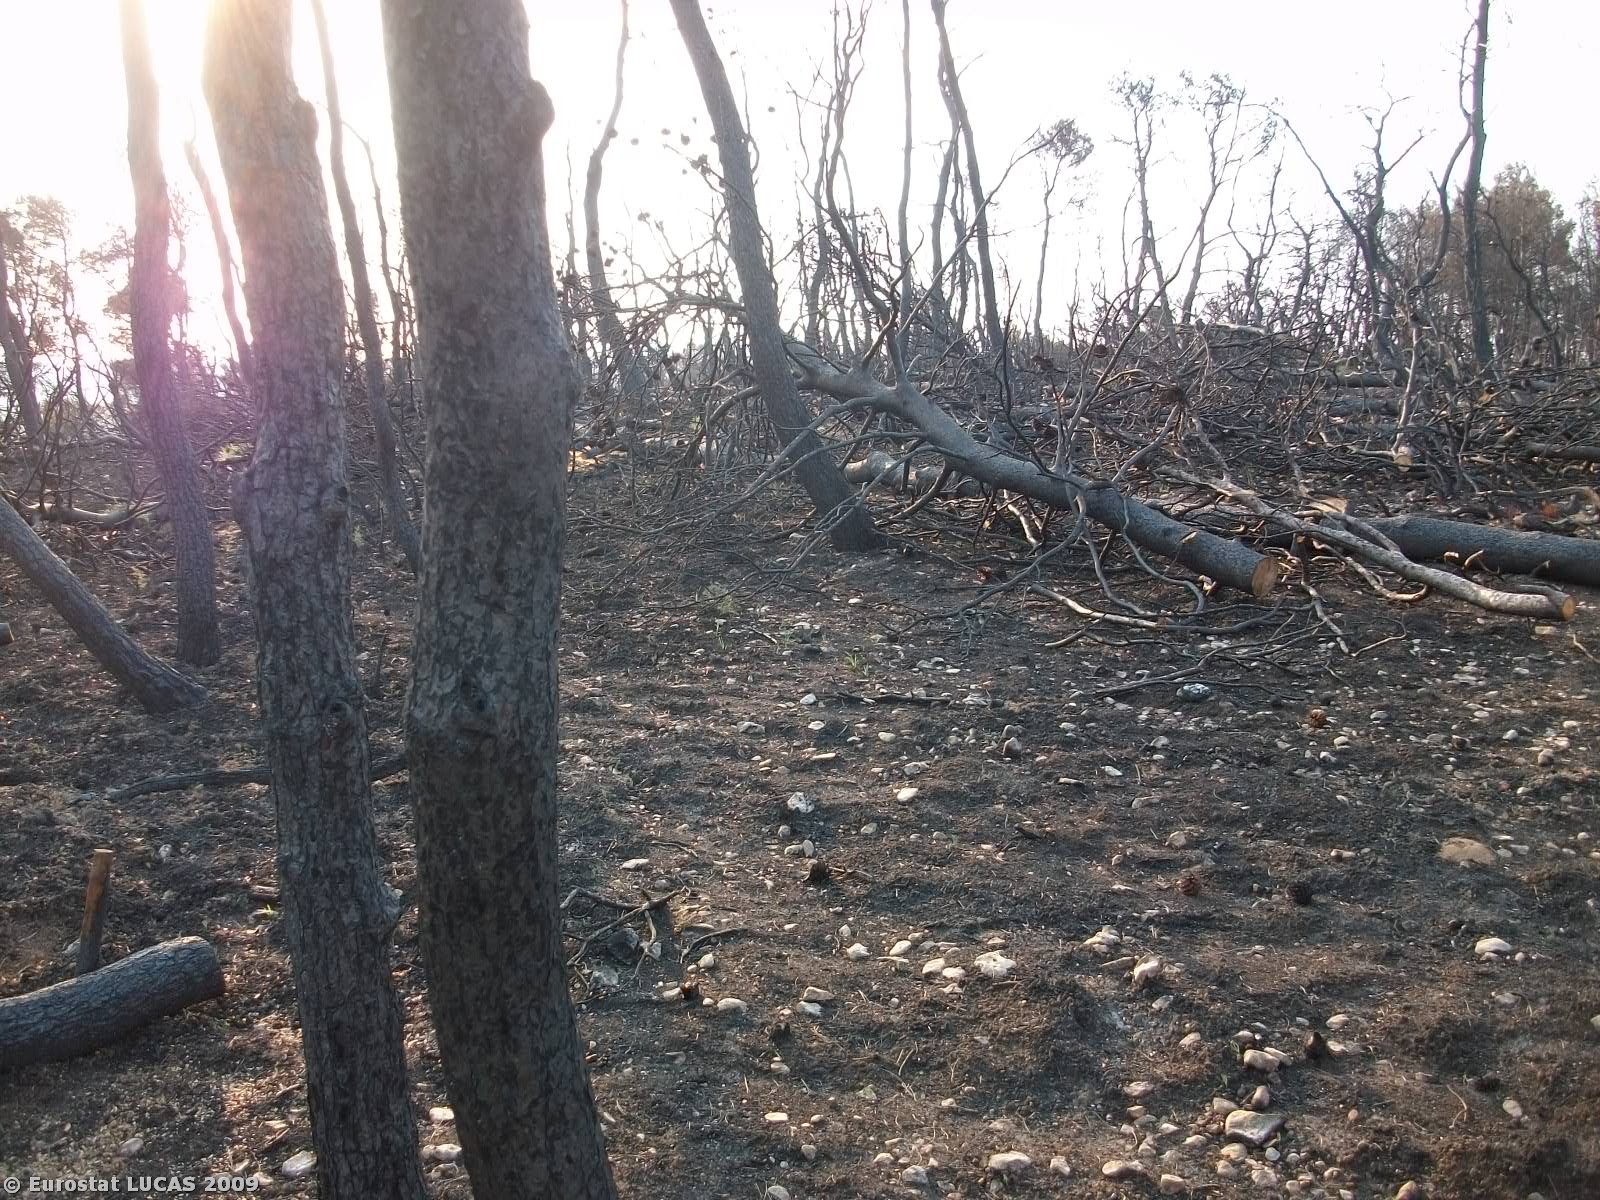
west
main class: Woodland
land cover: Coniferous woodland
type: coniferous forest of the mediterranean region
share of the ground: > 75 %
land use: Forestry
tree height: > 5 m
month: September
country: GR
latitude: 38.1720
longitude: 23.8998
